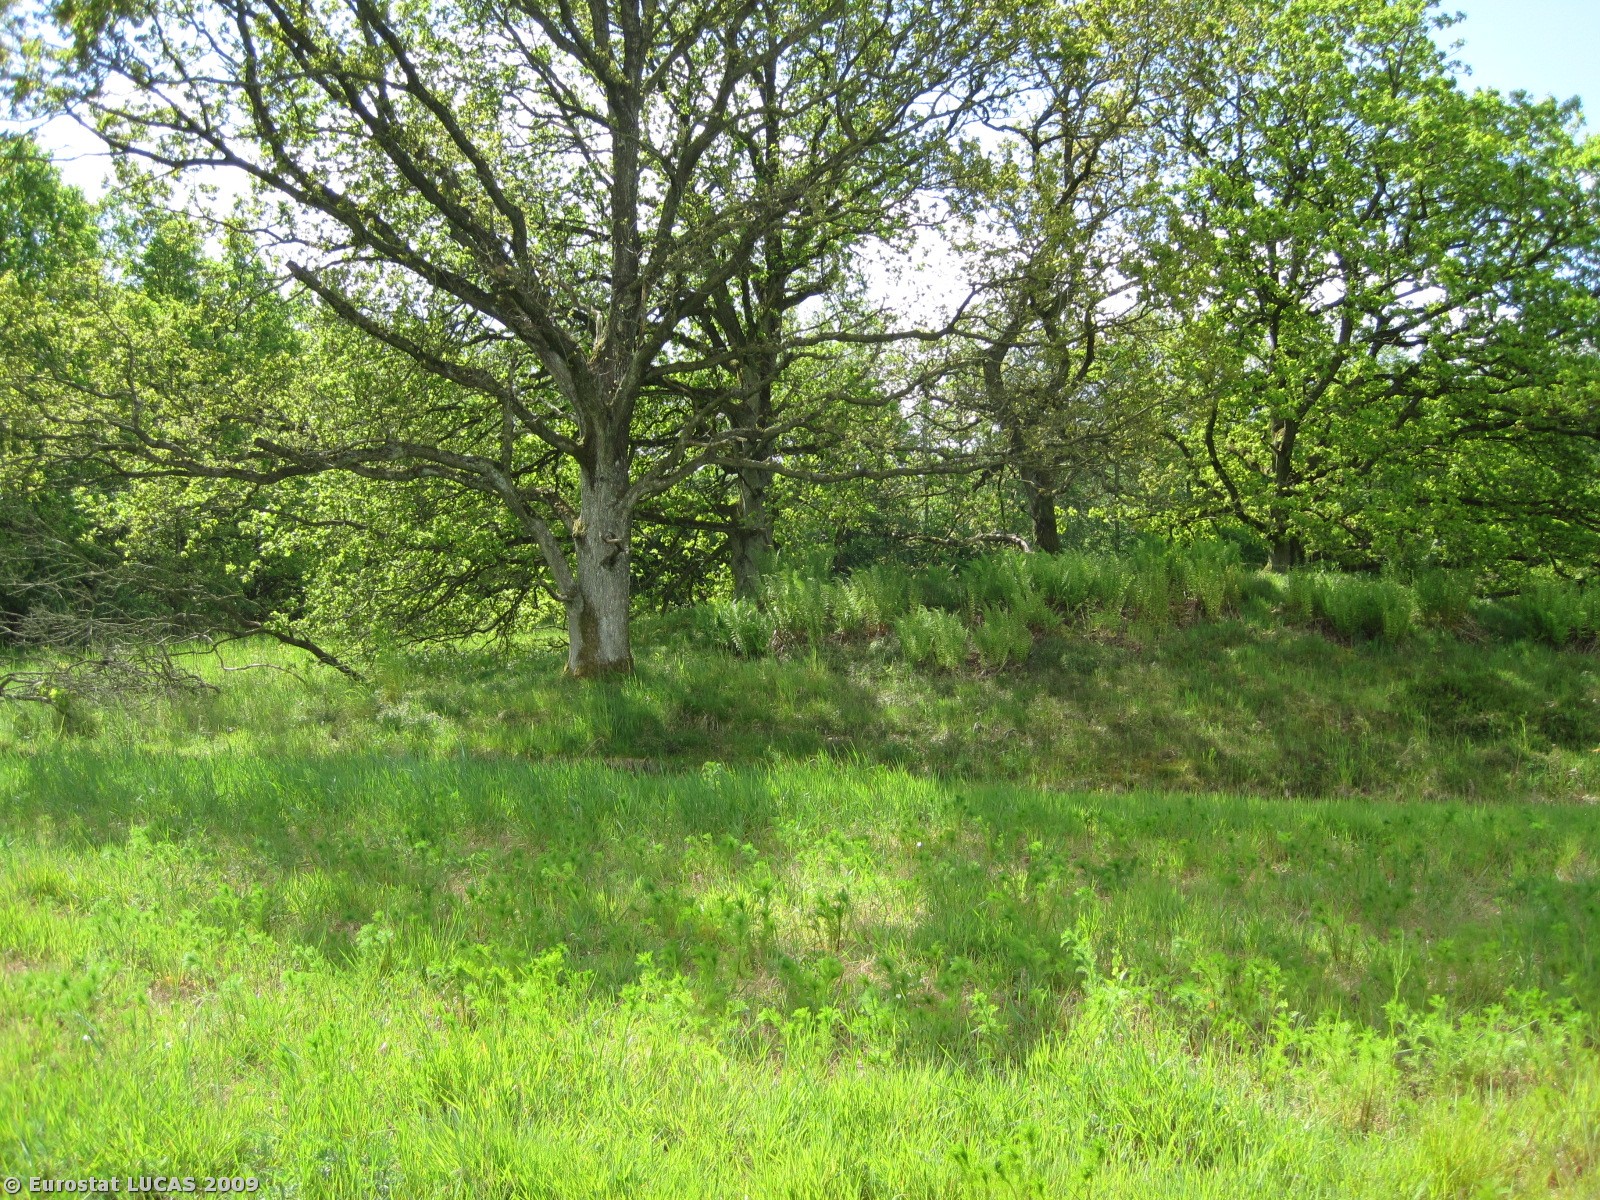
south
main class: Grassland
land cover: Grassland without tree/shrub cover
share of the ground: > 75 %
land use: Agriculture (excluding fallow land and kitchen gardens)
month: May
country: DK
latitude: 56.5471
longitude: 9.7888
